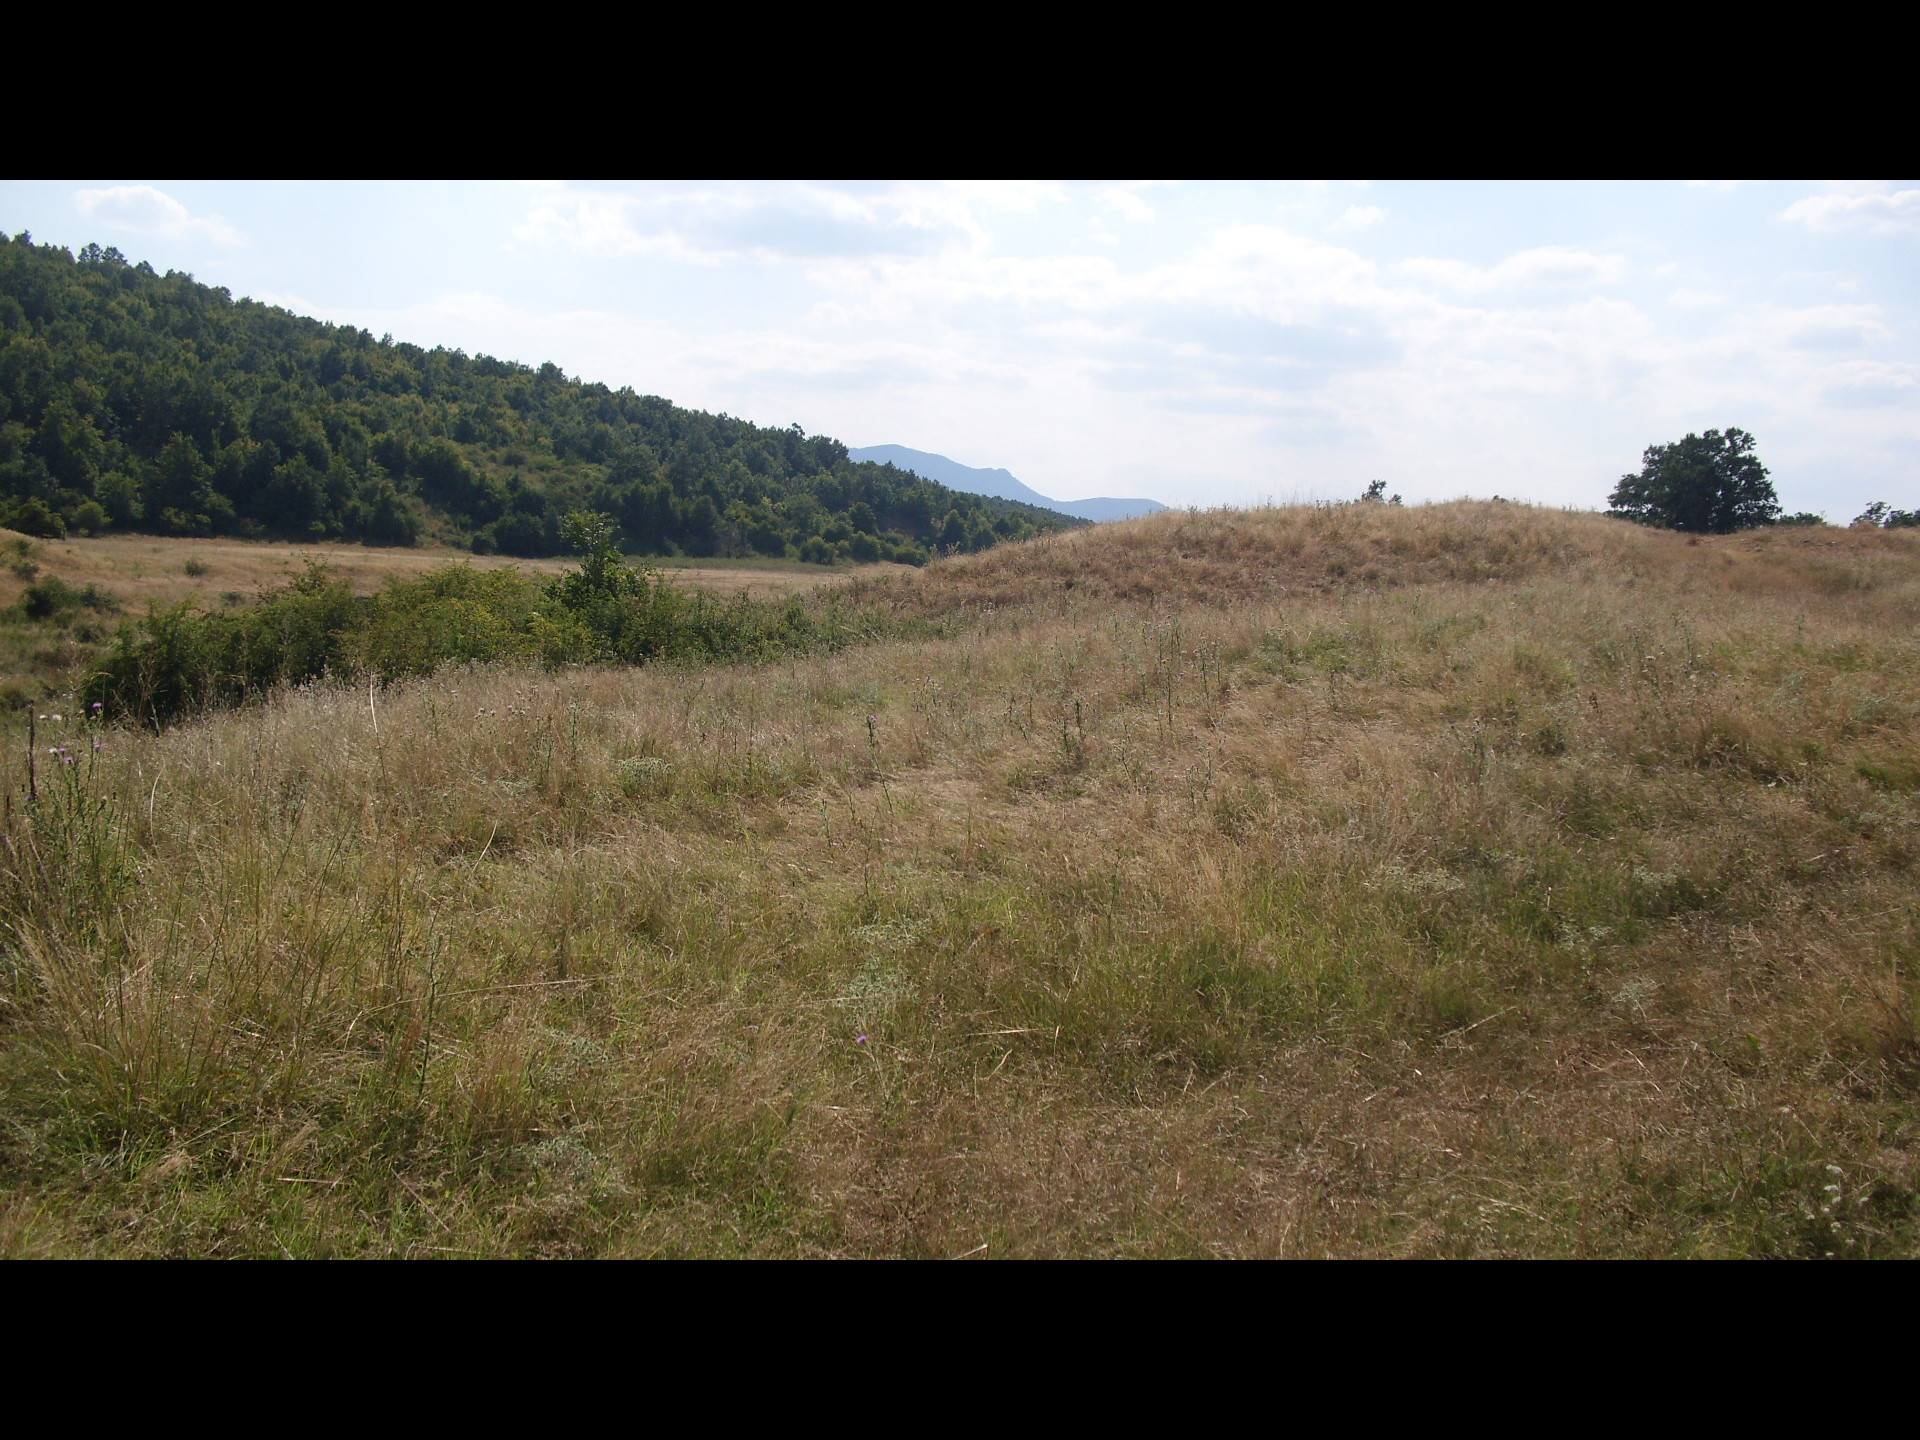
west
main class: Grassland
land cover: Grassland without tree/shrub cover
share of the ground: > 75 %
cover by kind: herbaceous plants 100 %
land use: Agriculture (excluding fallow land and kitchen gardens)
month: August
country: BG
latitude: 43.5476
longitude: 22.9965
